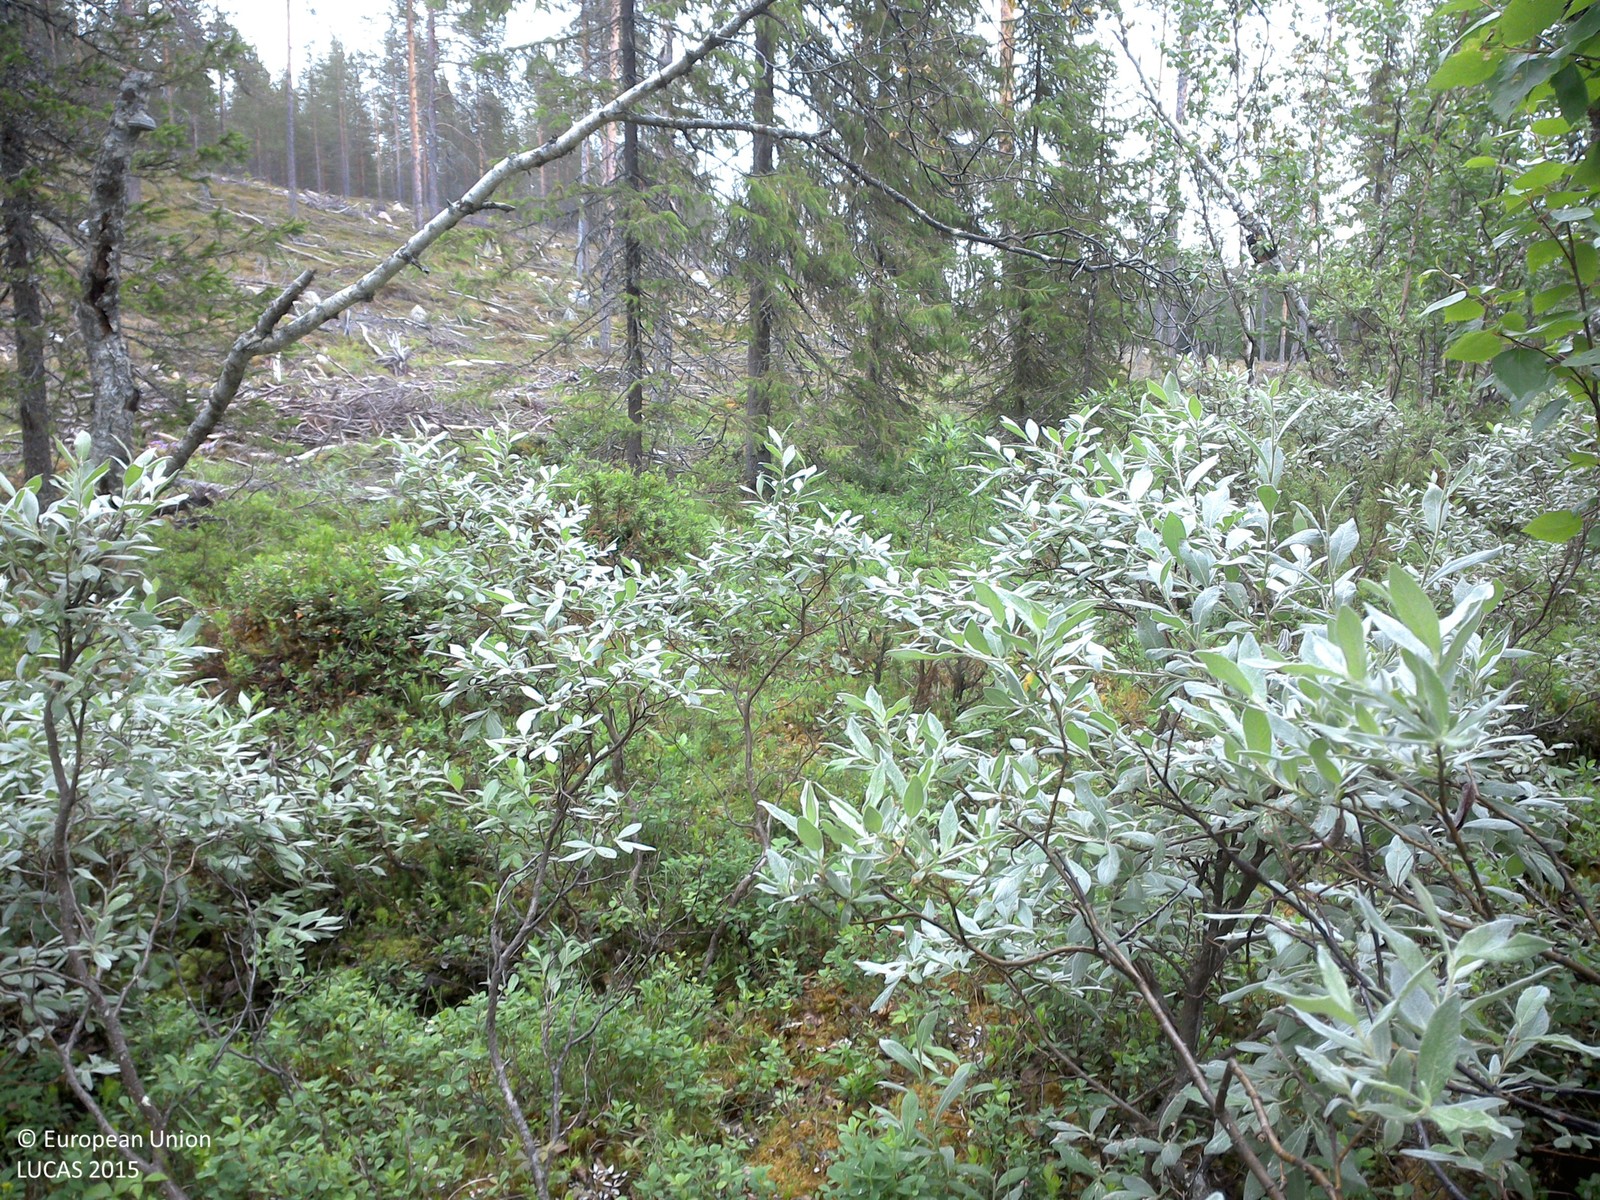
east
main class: Woodland
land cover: Spruce dominated mixed woodland
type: boreal forest
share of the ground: 25 - 50 %
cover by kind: shrubs 35 %, herbaceous plants 25 %, coniferous forest trees 20 %, broadleaved forest trees 15 %, lichens and mosses 5 %
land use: Forestry
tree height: > 5 m
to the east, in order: Spruce dominated mixed woodland; Pine dominated coniferous woodland; Shrubland with sparse tree cover
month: July
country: SE
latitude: 67.7530
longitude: 23.0965
